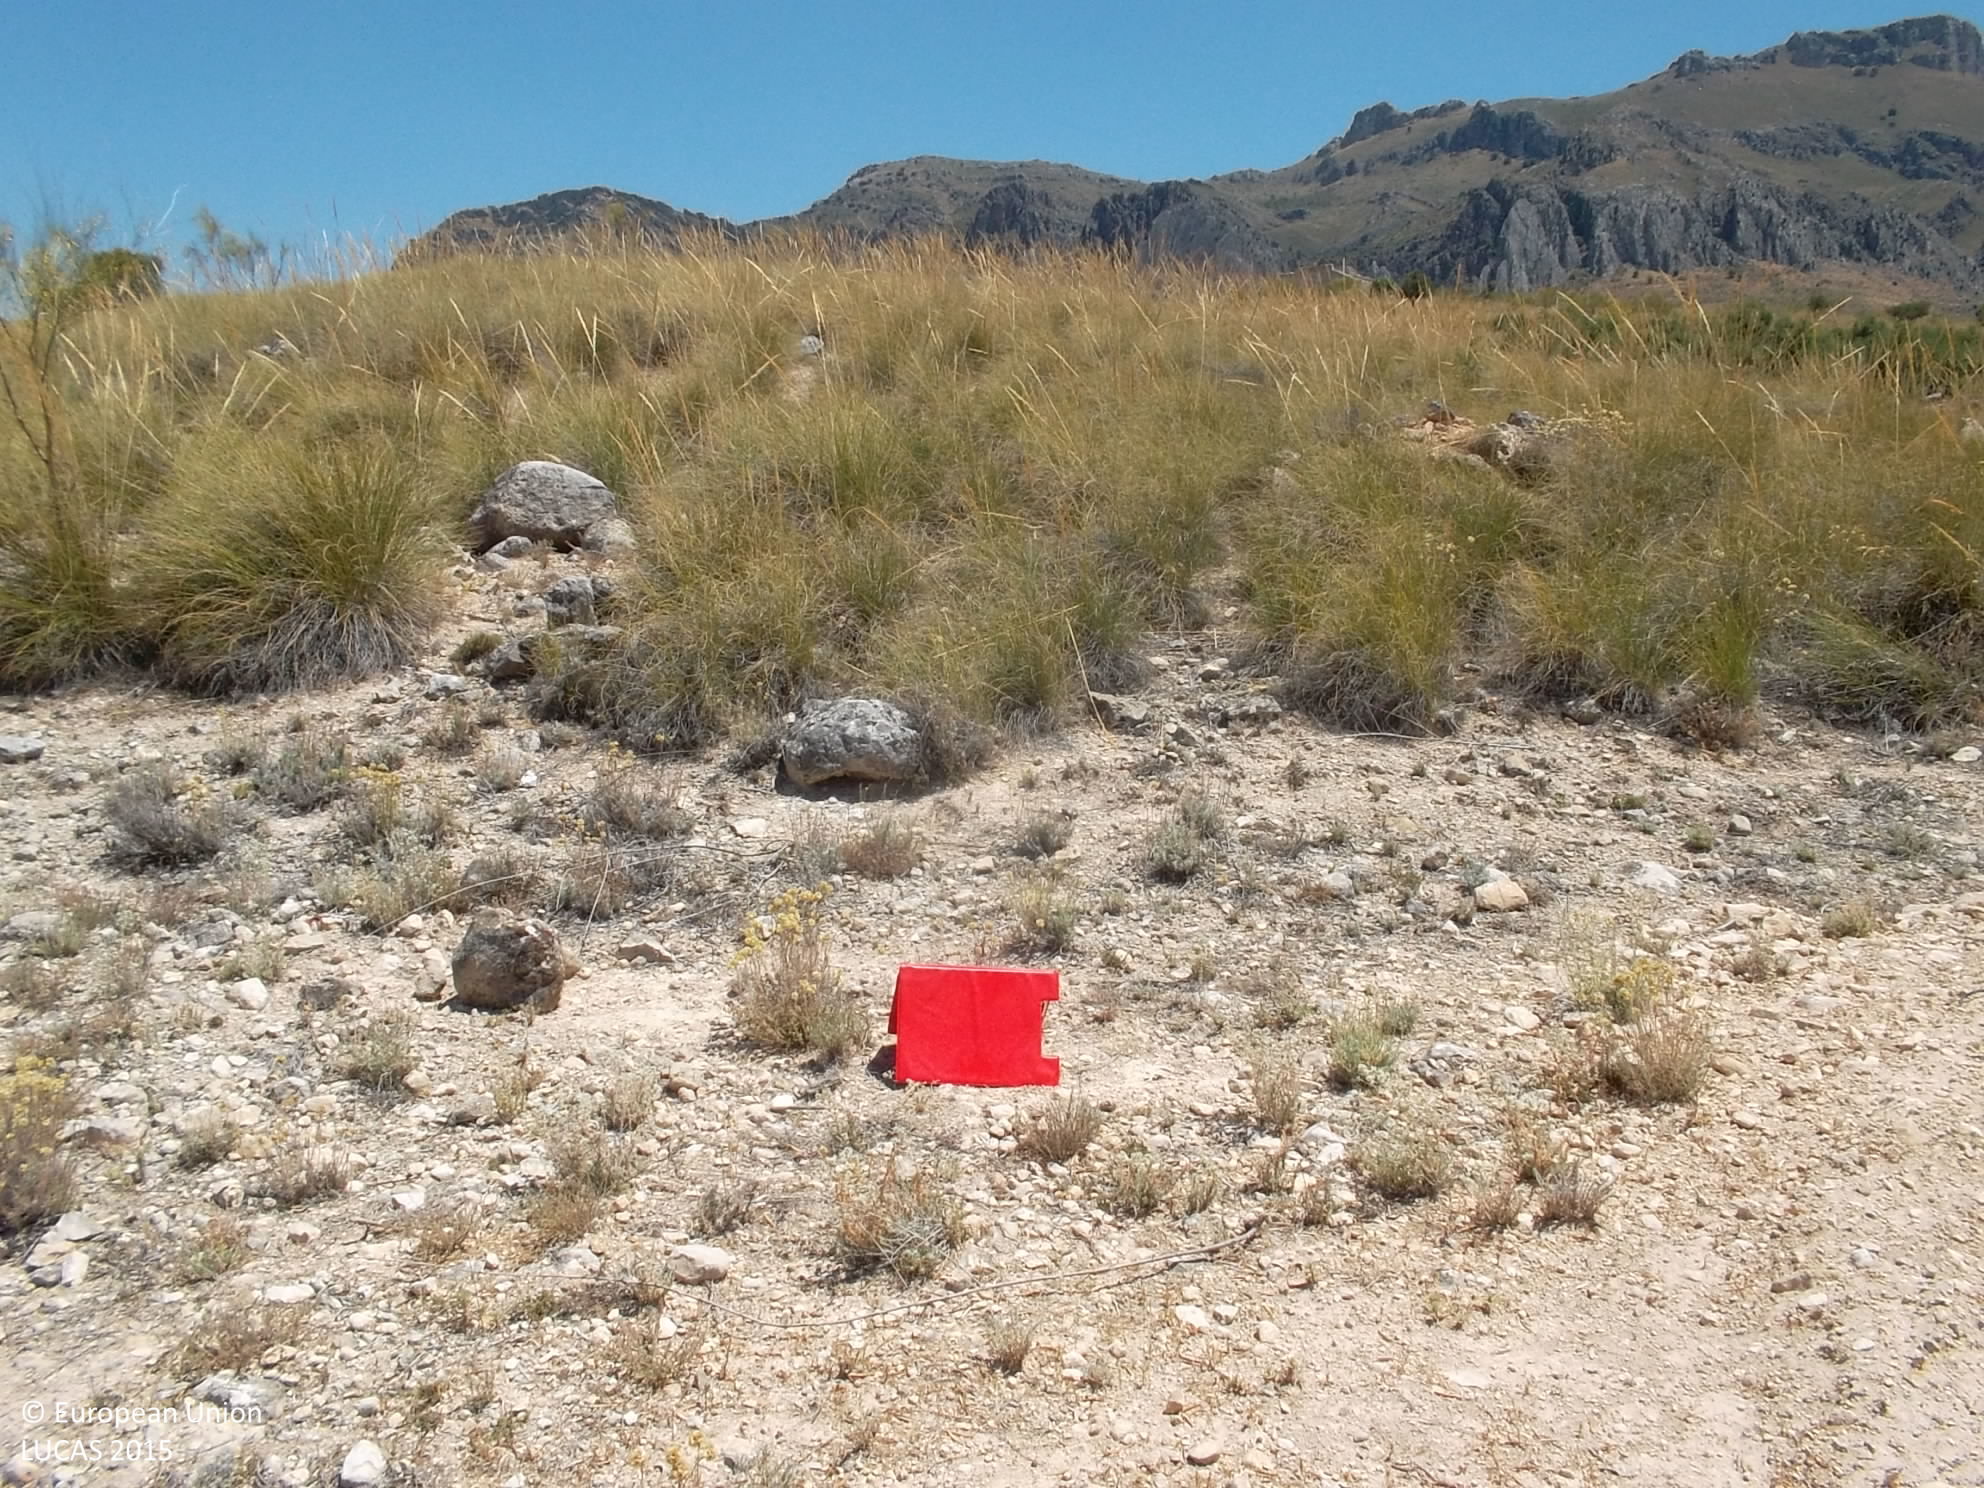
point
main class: Cropland
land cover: Olive groves
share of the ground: 25 - 50 %
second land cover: Other bare soil
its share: > 75 %
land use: Agriculture (excluding fallow land and kitchen gardens)
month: June
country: ES
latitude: 37.8590
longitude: -3.3988
